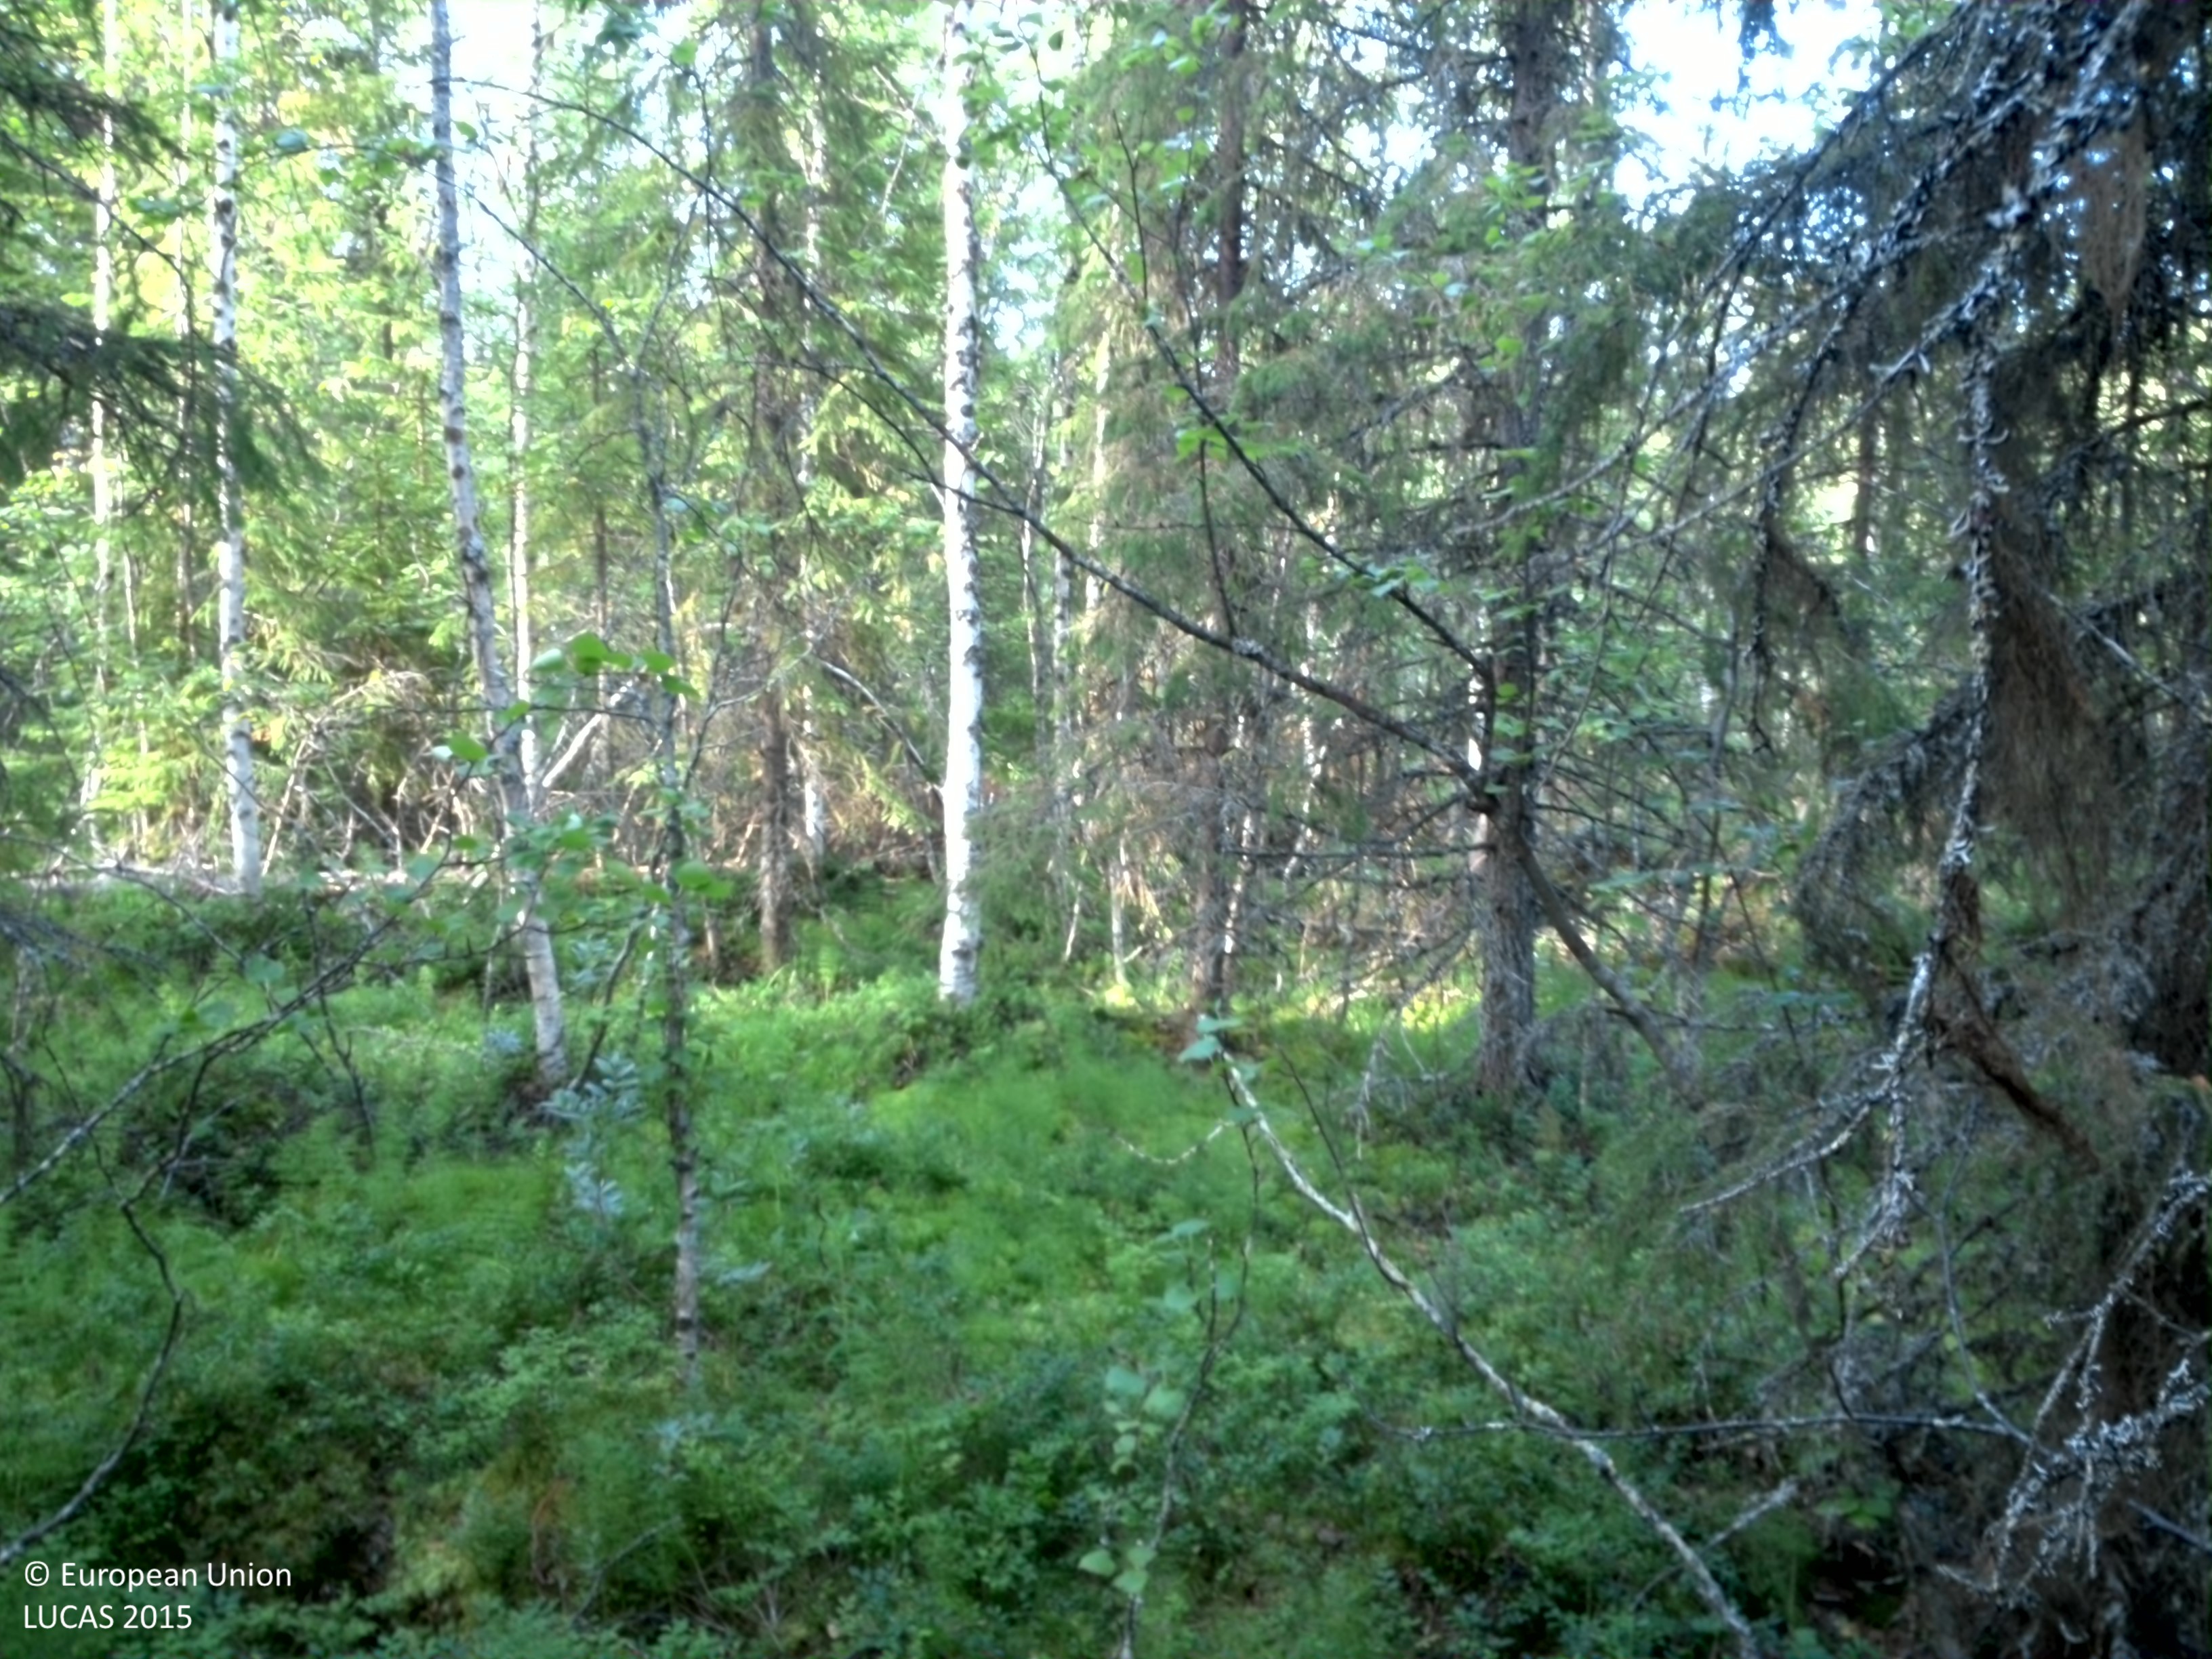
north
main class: Woodland
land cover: Spruce dominated mixed woodland
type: boreal forest
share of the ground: 50 - 75 %
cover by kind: coniferous forest trees 40 %, broadleaved forest trees 25 %, shrubs 25 %, lichens and mosses 10 %
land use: Forestry
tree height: > 5 m
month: August
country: SE
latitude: 64.7381
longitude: 16.4559
